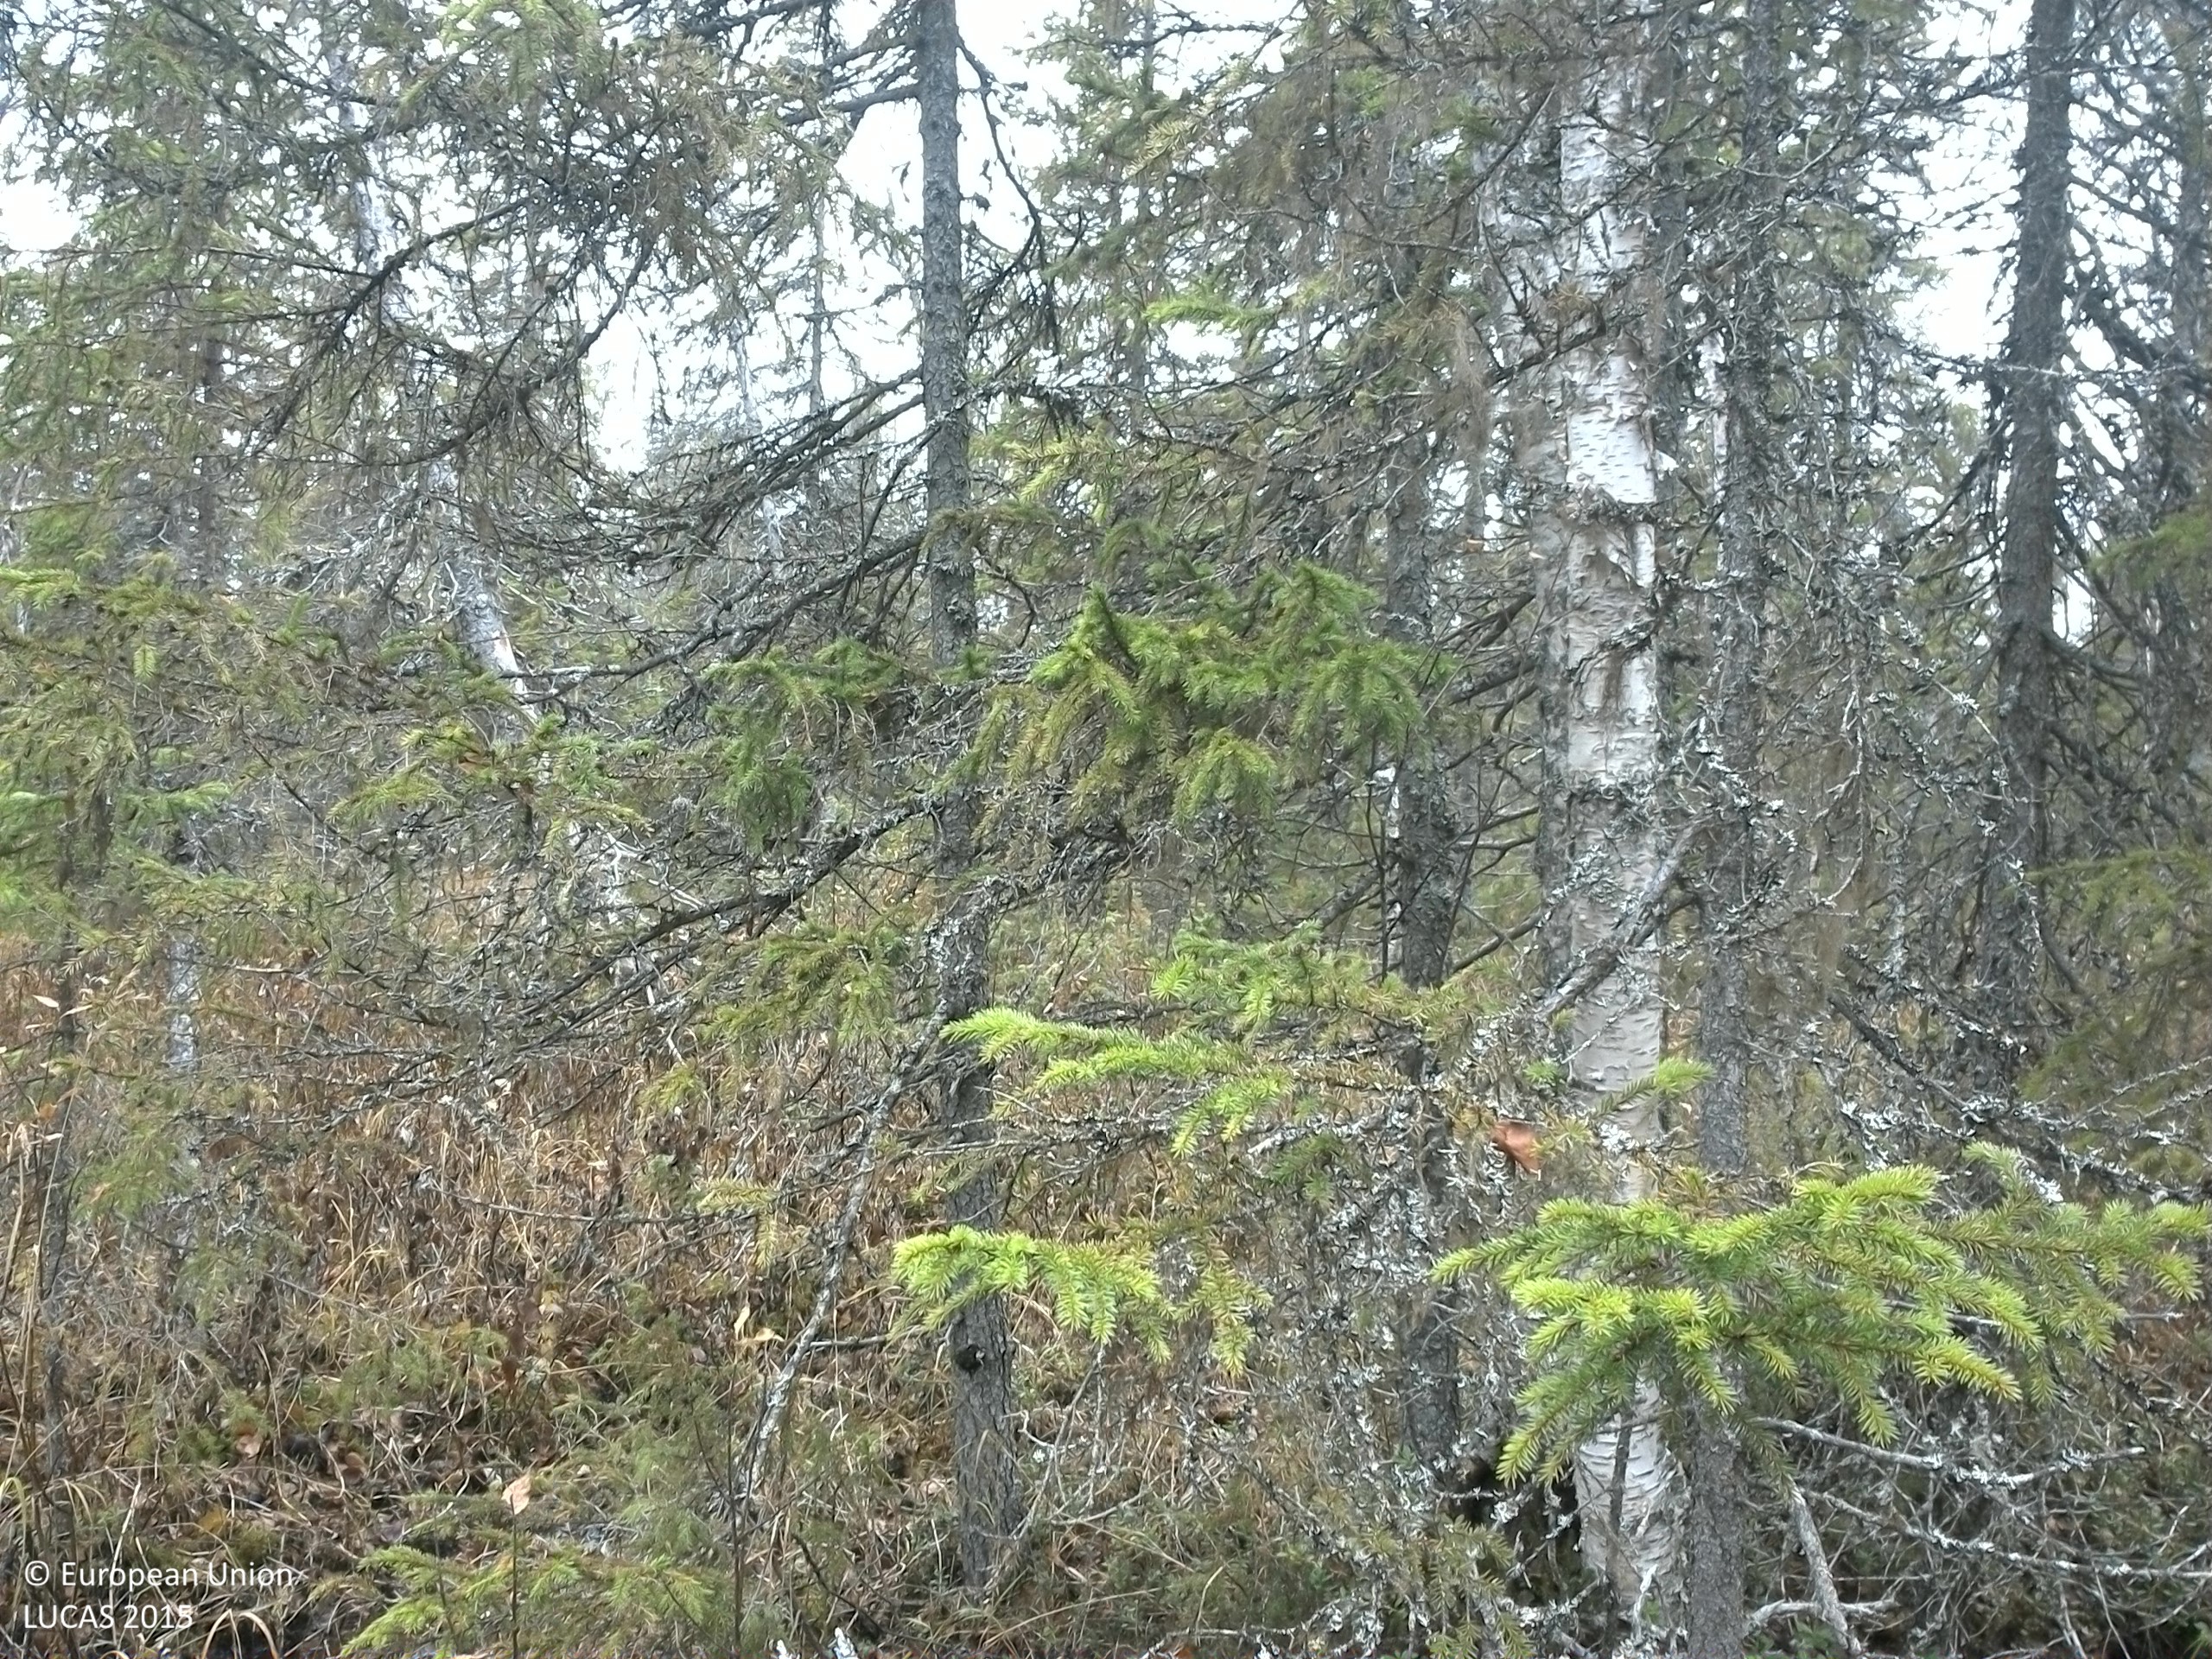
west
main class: Woodland
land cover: Spruce dominated mixed woodland
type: boreal forest
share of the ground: 50 - 75 %
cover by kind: coniferous forest trees 40 %, shrubs 25 %, broadleaved forest trees 15 %, lichens and mosses 15 %
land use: Forestry
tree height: > 5 m
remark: Temporary flooded
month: October
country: SE
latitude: 64.3433
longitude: 15.3740
